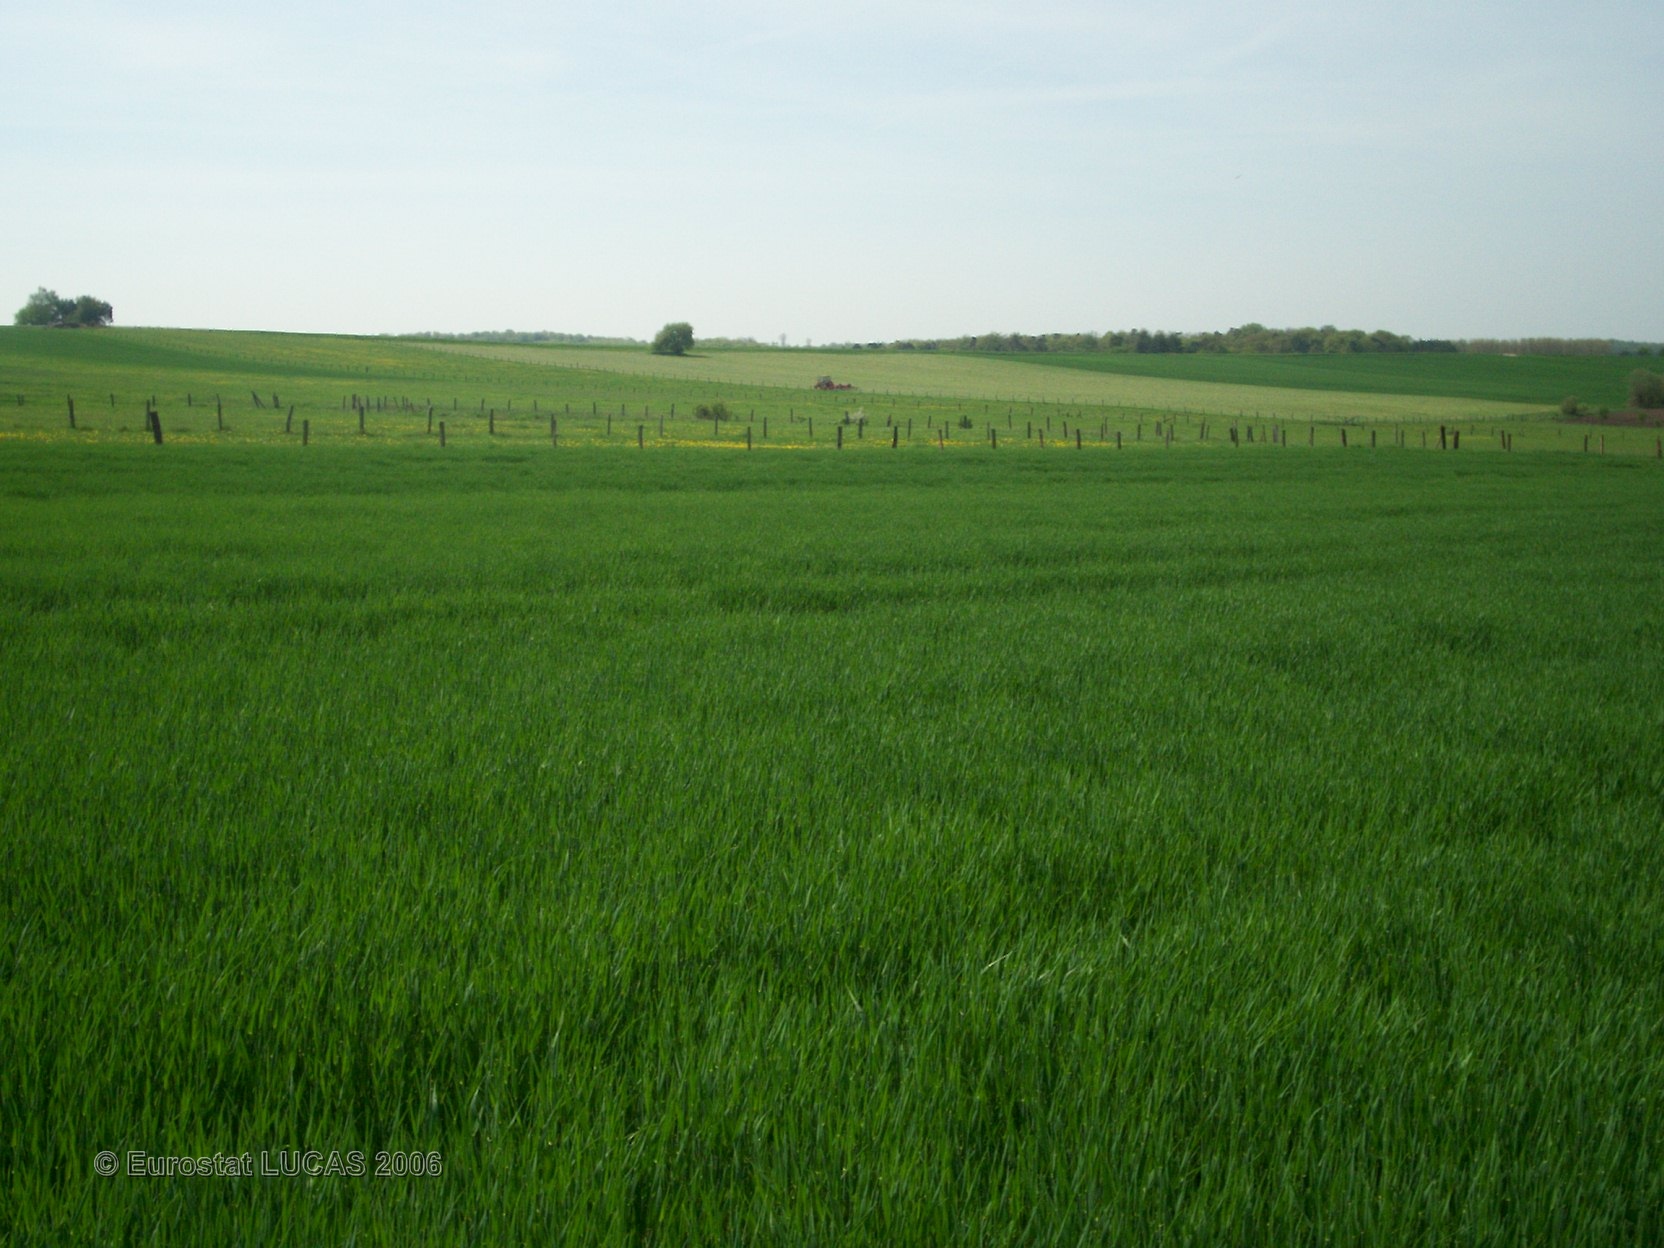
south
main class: Cropland
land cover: Barley
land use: Agriculture (excluding fallow land and kitchen gardens)
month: May
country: FR
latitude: 48.9392
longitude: 7.0106
